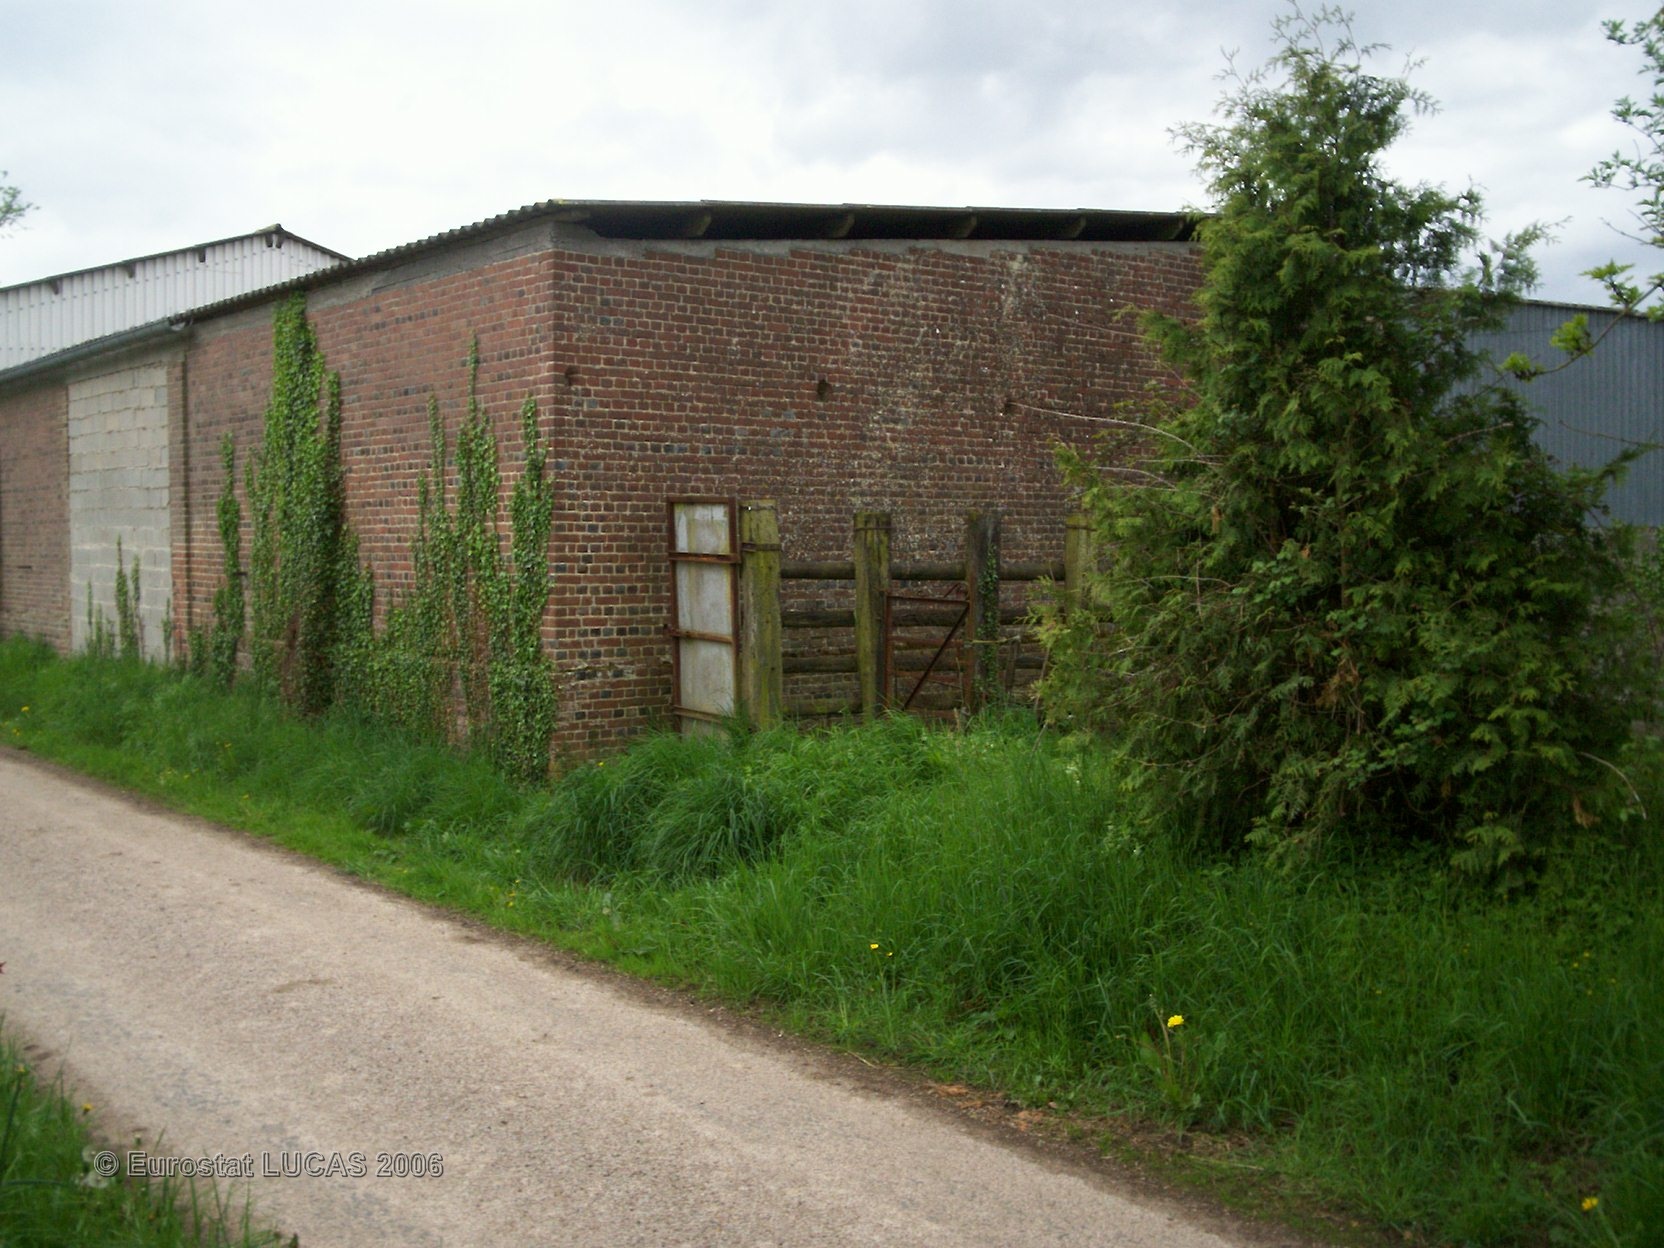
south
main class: Grassland
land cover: Grassland without tree/shrub cover
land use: Agriculture (excluding fallow land and kitchen gardens)
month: May
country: FR
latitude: 49.1172
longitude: 0.5065
